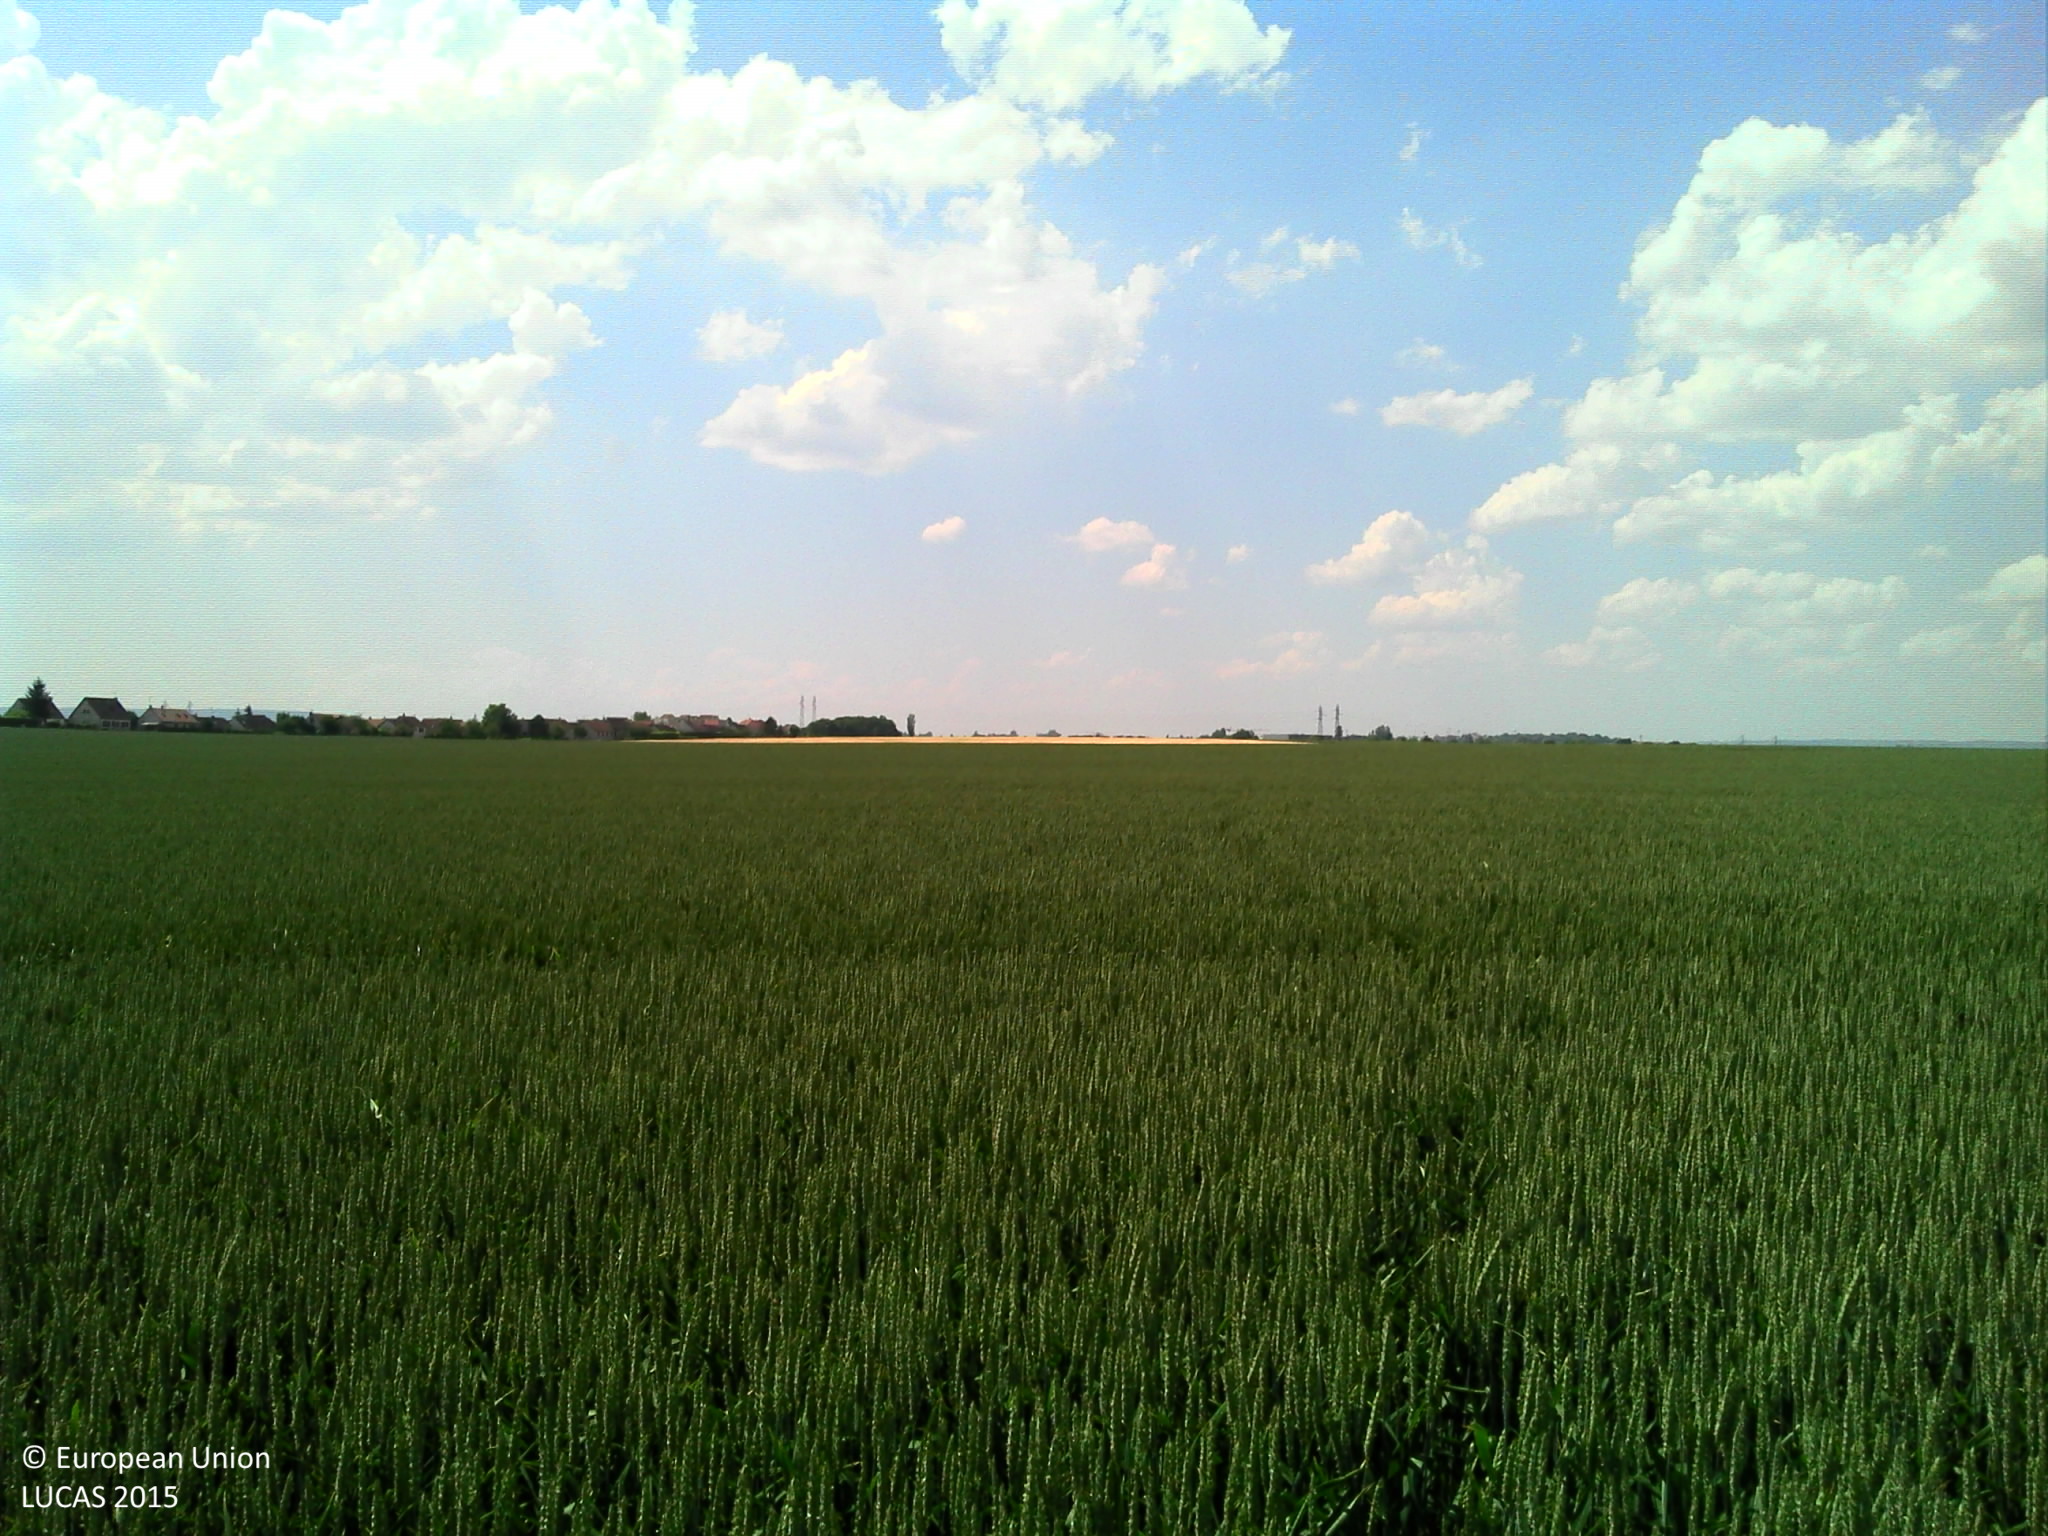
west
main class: Cropland
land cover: Common wheat
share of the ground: > 75 %
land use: Agriculture (excluding fallow land and kitchen gardens)
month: June
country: FR
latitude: 47.3221
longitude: 5.1185
